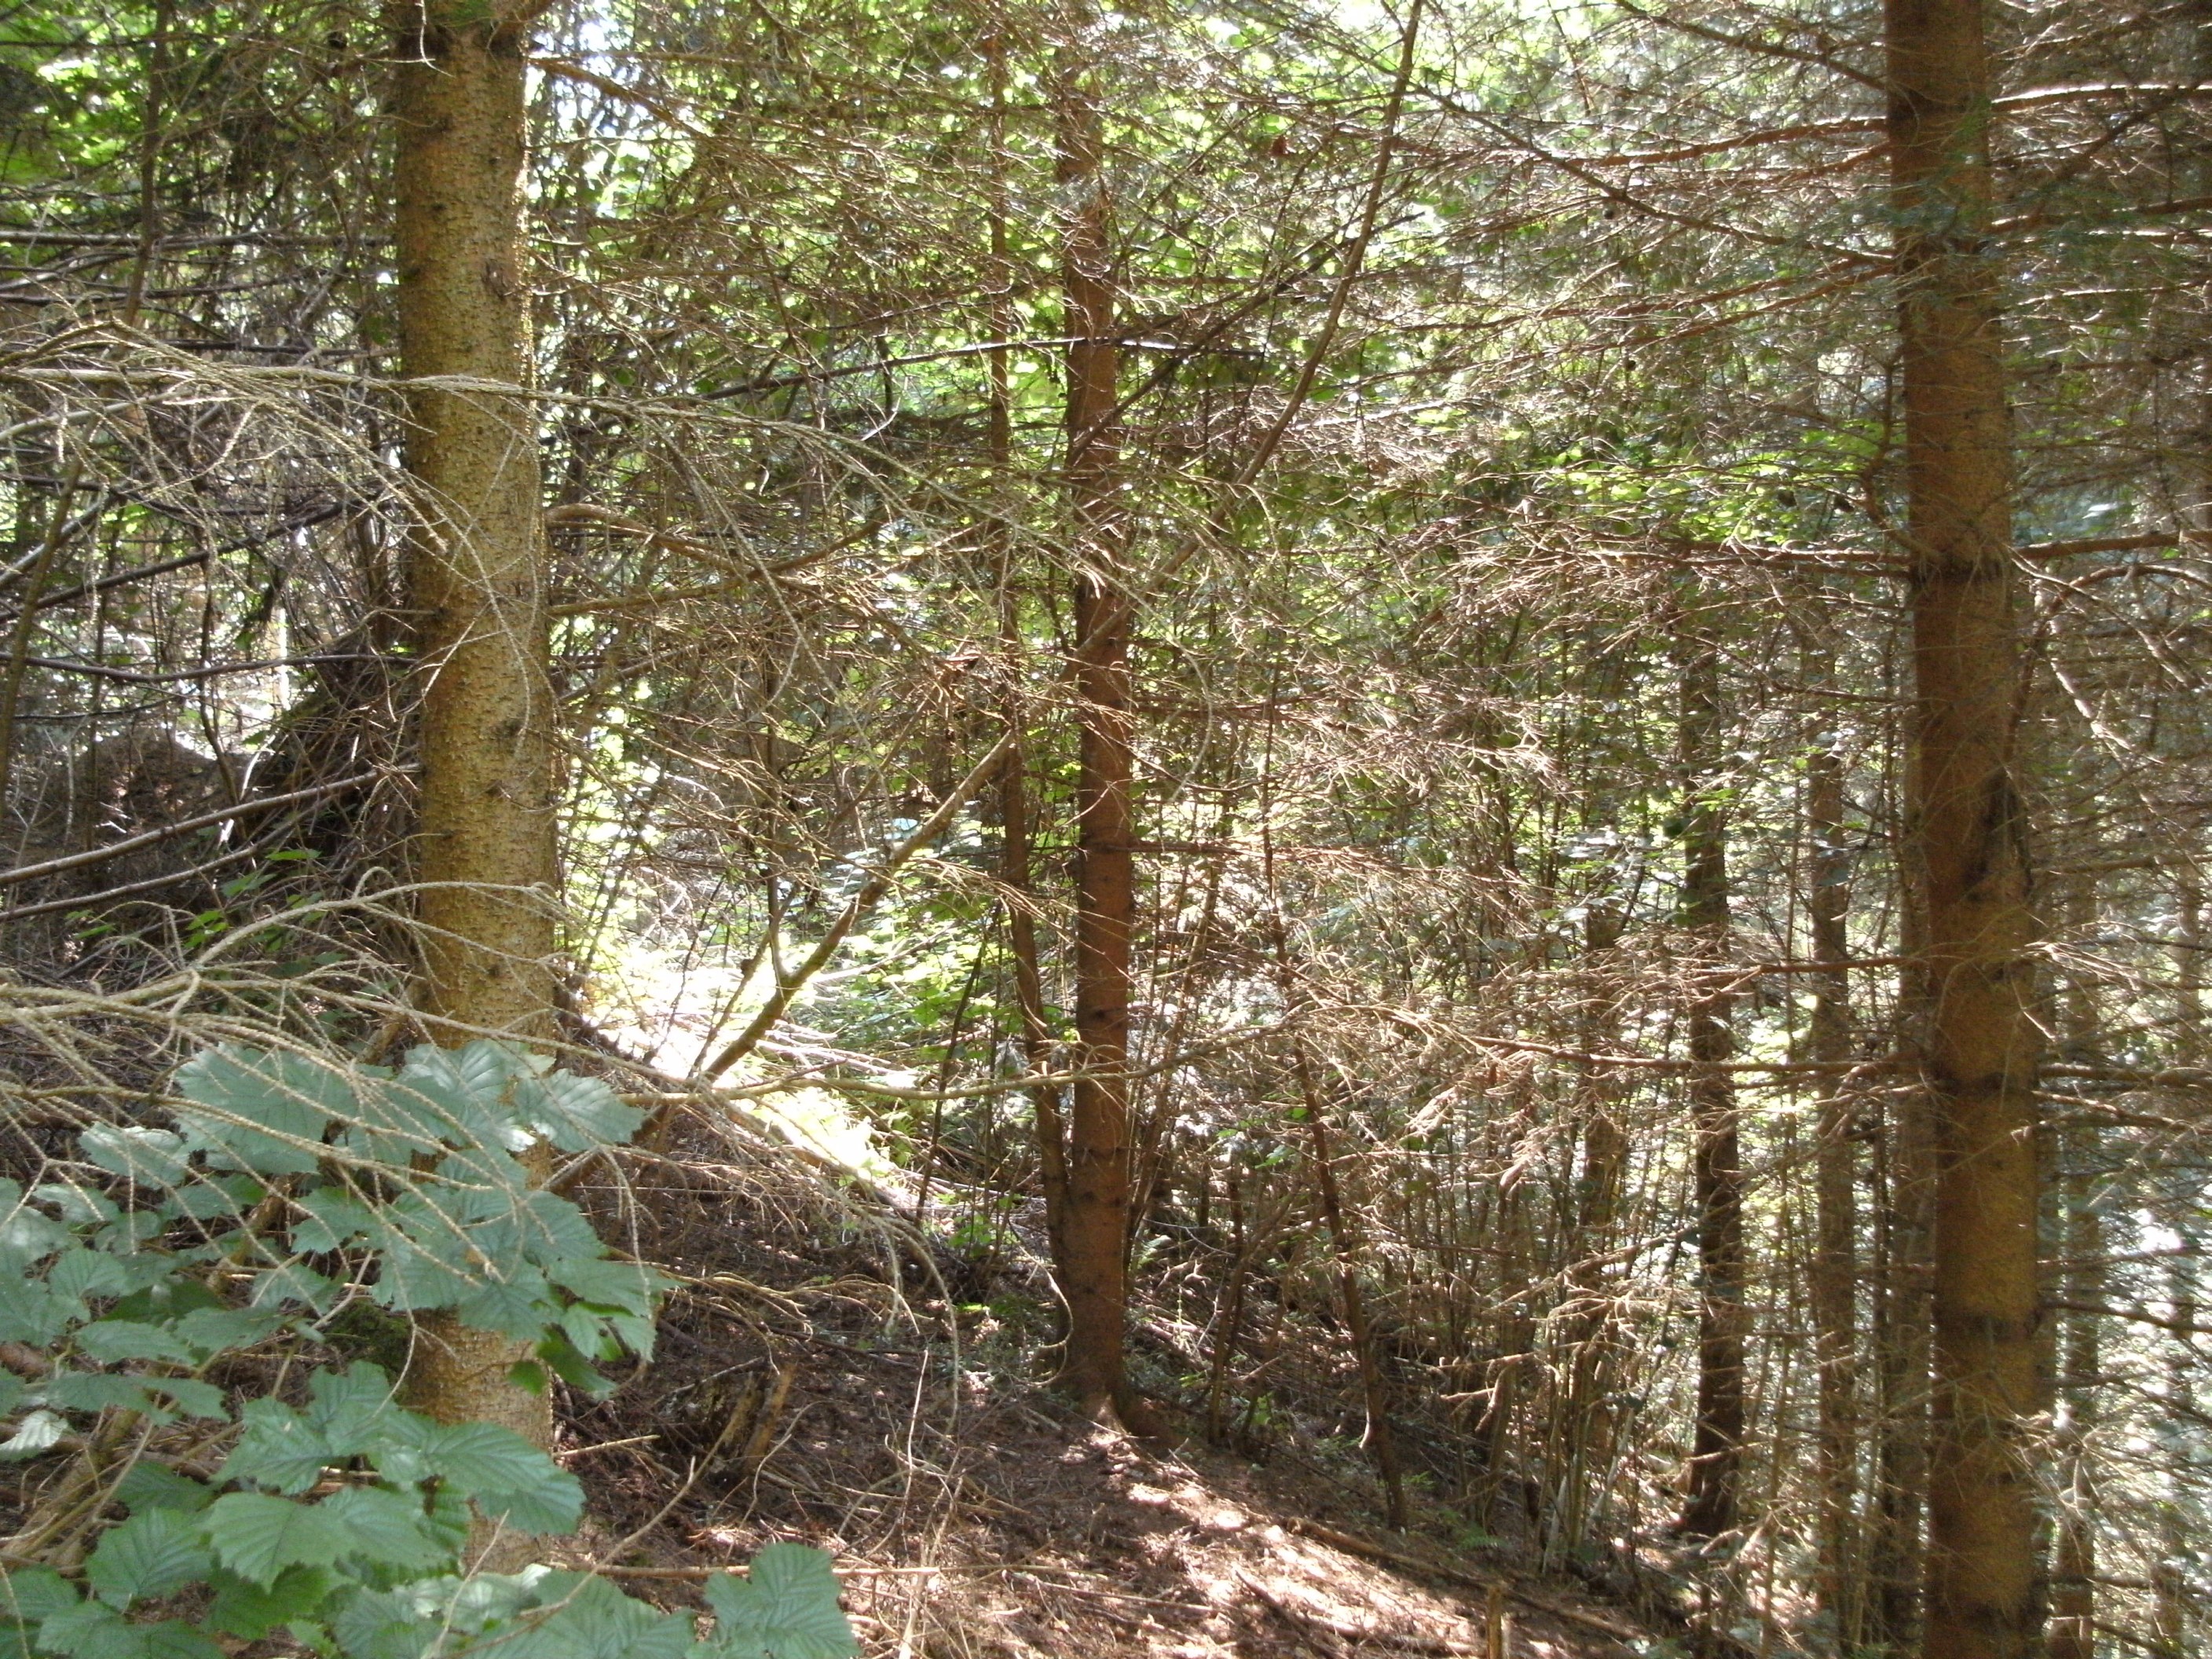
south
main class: Woodland
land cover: Spruce dominated mixed woodland
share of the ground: 50 - 75 %
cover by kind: broadleaved forest trees 35 %, shrubs 30 %, coniferous forest trees 20 %, unconsolidated bare surface 10 %, herbaceous plants 5 %
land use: Forestry
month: July
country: AT
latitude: 46.7677
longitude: 14.7777
